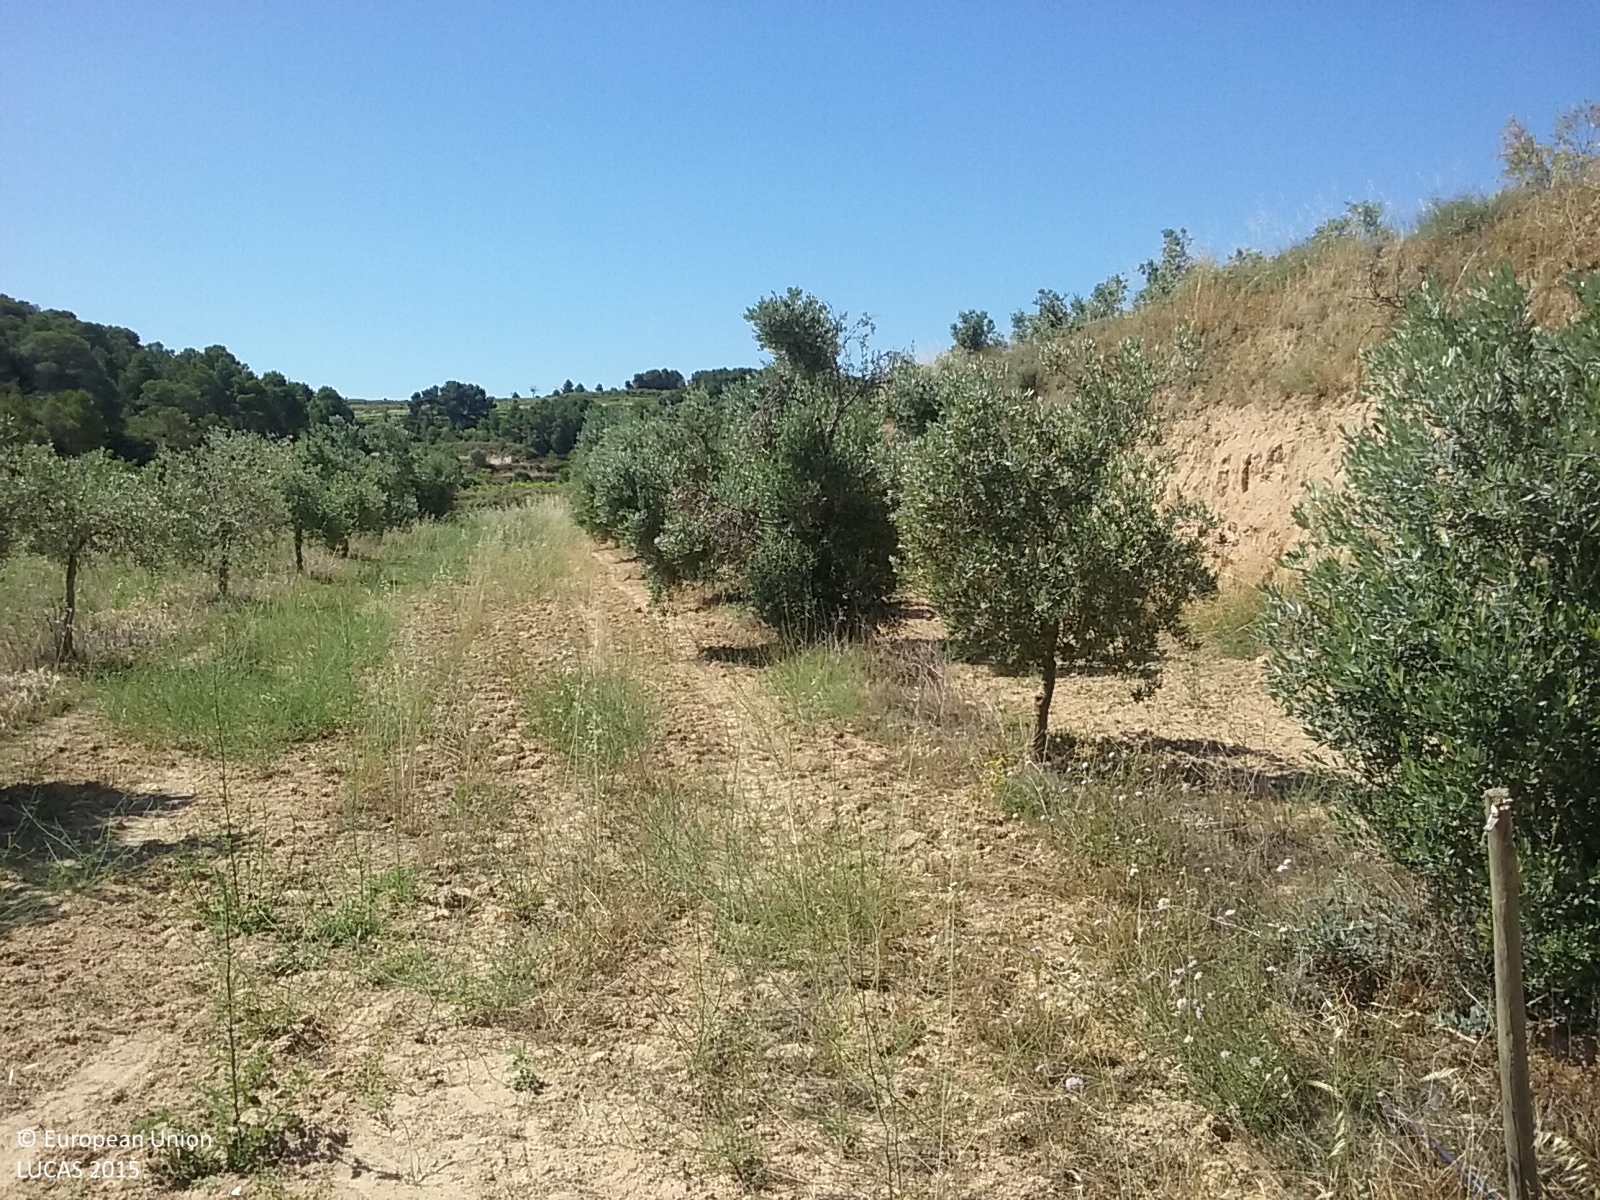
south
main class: Cropland
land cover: Vineyards
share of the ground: 10 - 25 %
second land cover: Other bare soil
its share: > 75 %
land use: Agriculture (excluding fallow land and kitchen gardens)
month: June
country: ES
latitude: 41.0794
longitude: 0.3137
